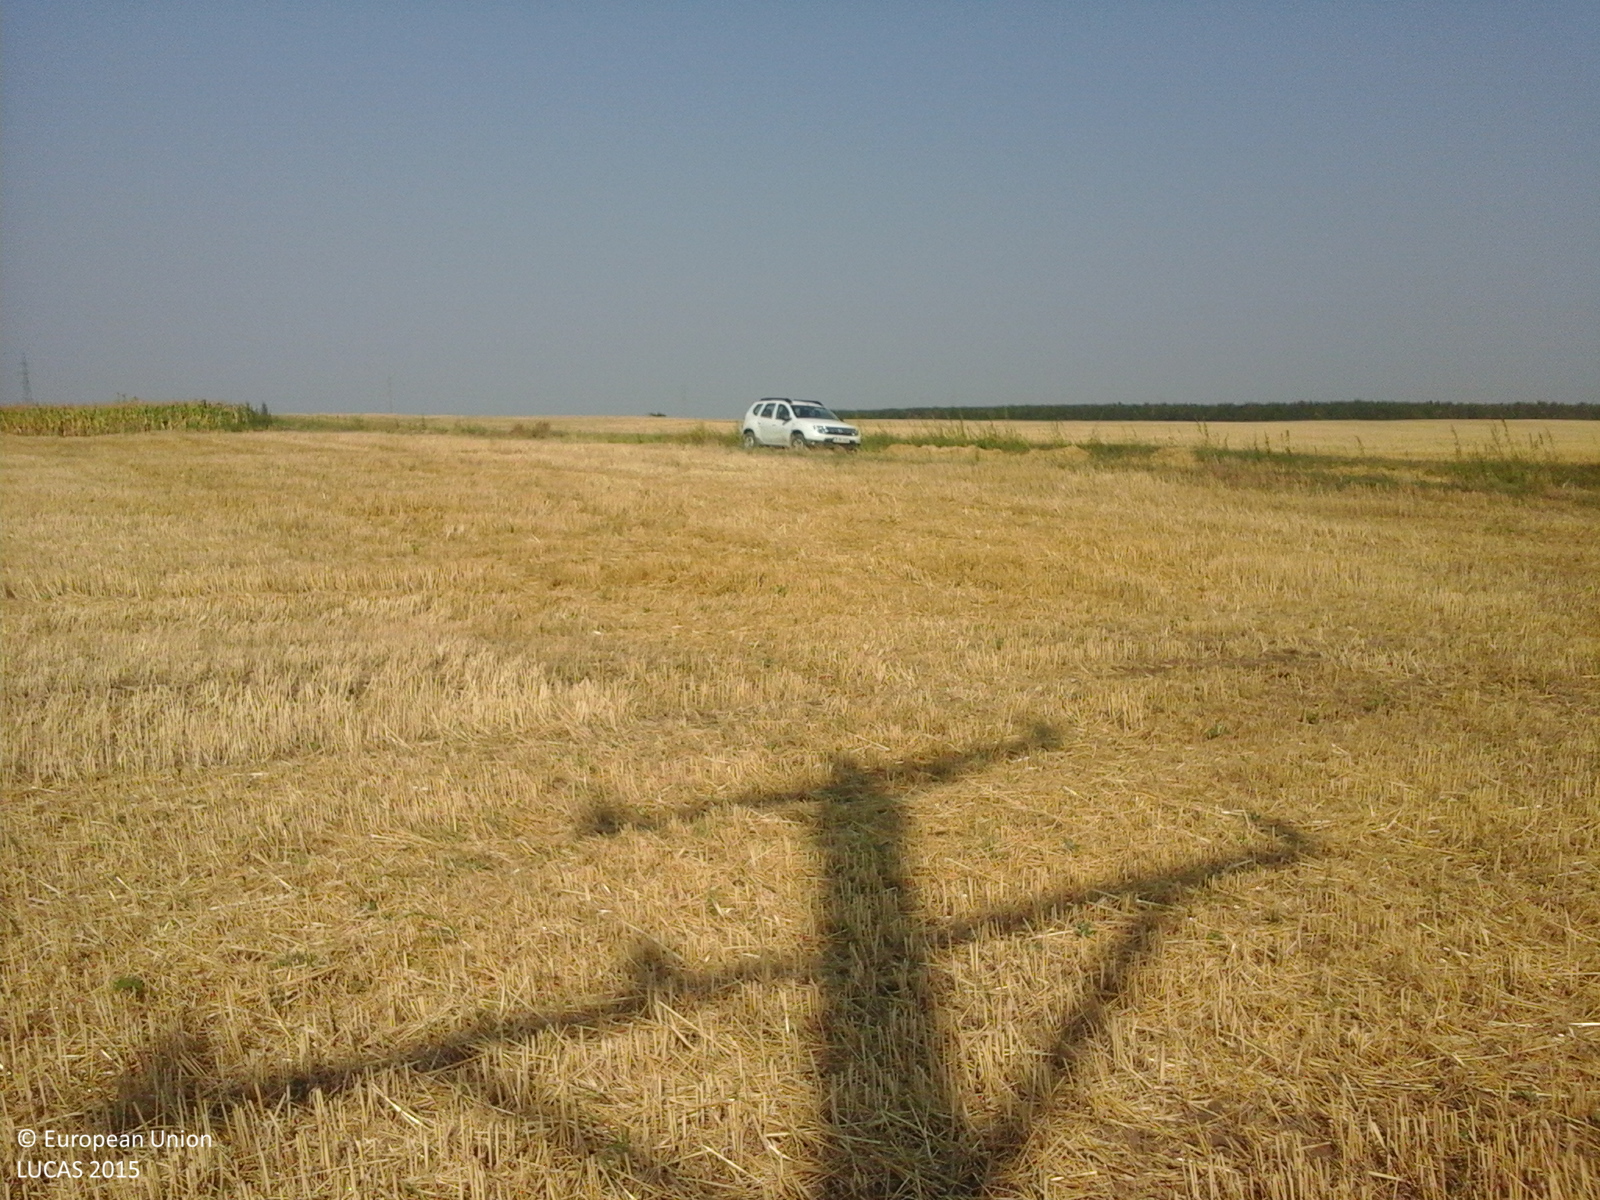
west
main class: Cropland
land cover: Common wheat
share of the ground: > 75 %
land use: Agriculture (excluding fallow land and kitchen gardens)
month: August
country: RO
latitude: 45.7336
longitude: 27.5444
